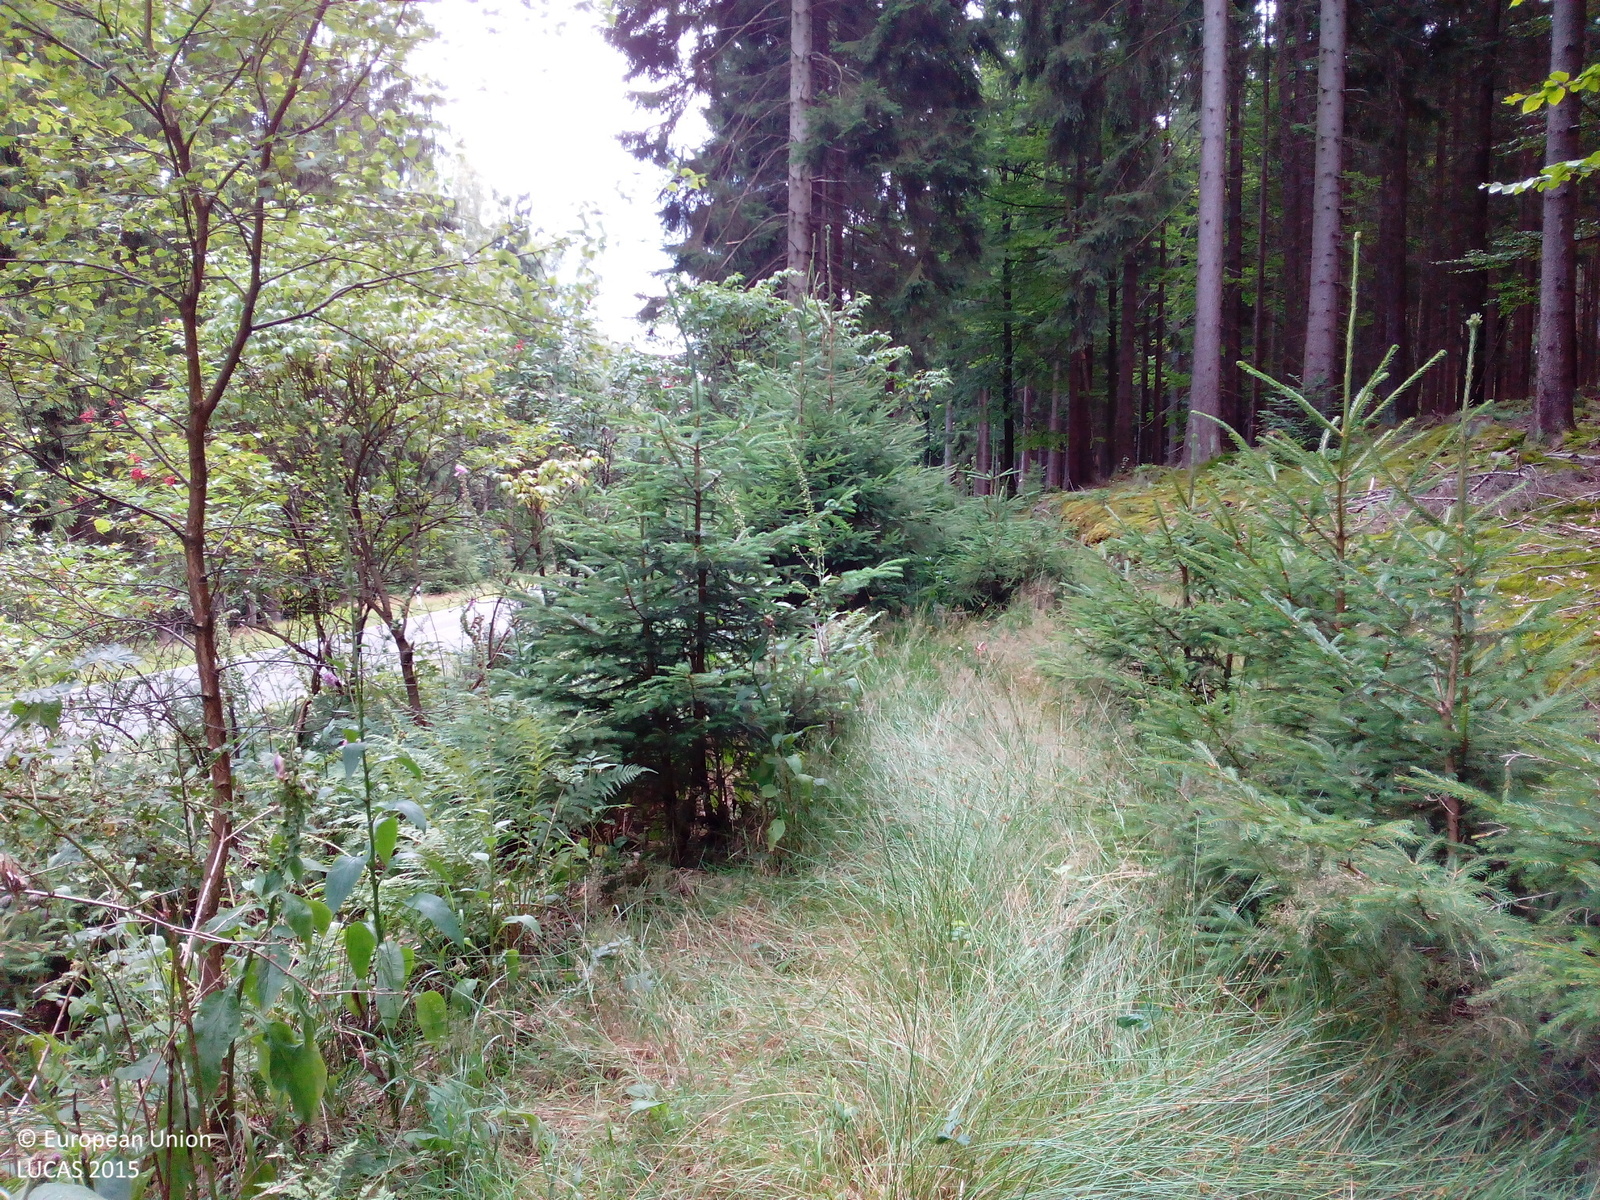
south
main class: Woodland
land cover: Spruce dominated mixed woodland
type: hemiboreal forest and nemoral coniferous forest and mixed broadleaved-coniferous forest
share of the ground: > 75 %
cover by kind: coniferous forest trees 50 %, broadleaved forest trees 25 %, herbaceous plants 15 %, shrubs 10 %
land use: Forestry
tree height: < 5 m
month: July
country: DE
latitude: 49.7817
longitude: 12.3745
